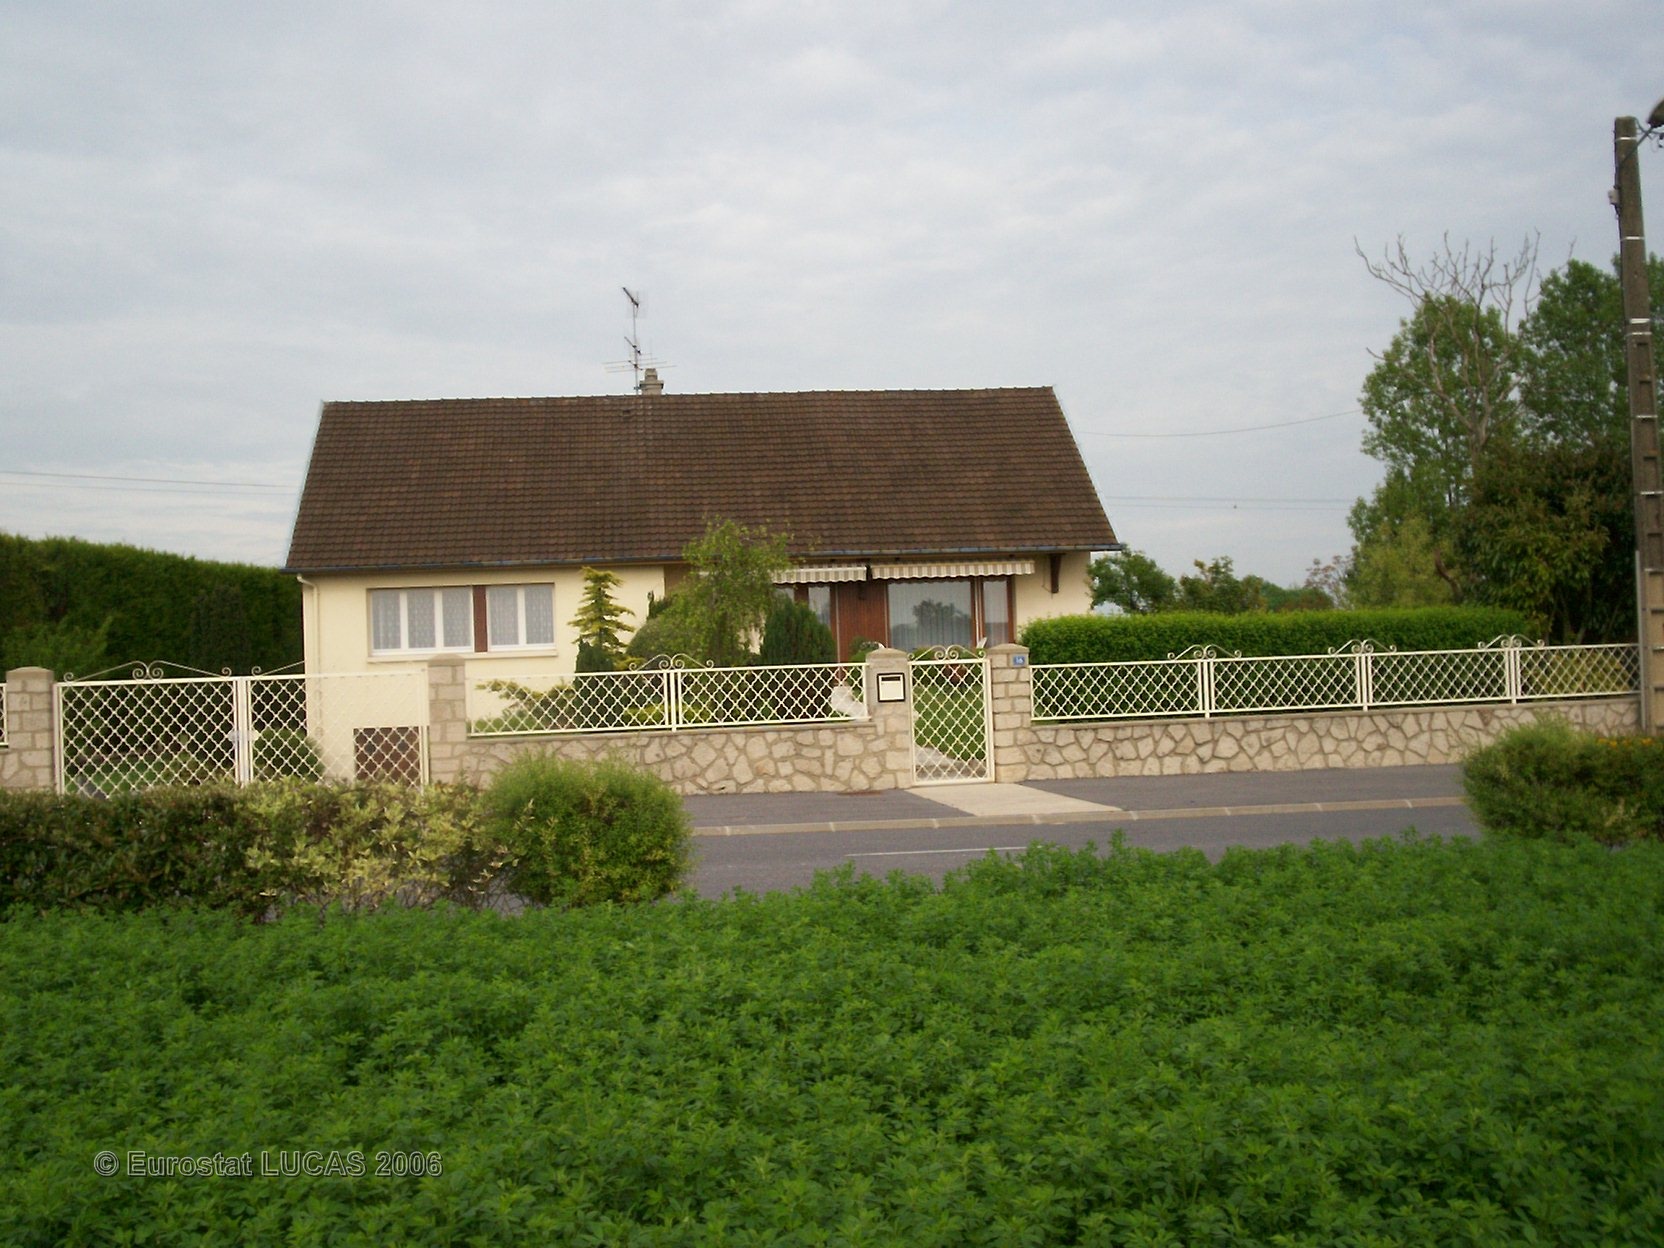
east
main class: Cropland
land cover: Lucerne
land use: Agriculture (excluding fallow land and kitchen gardens)
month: May
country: FR
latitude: 49.1433
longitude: 4.3620
